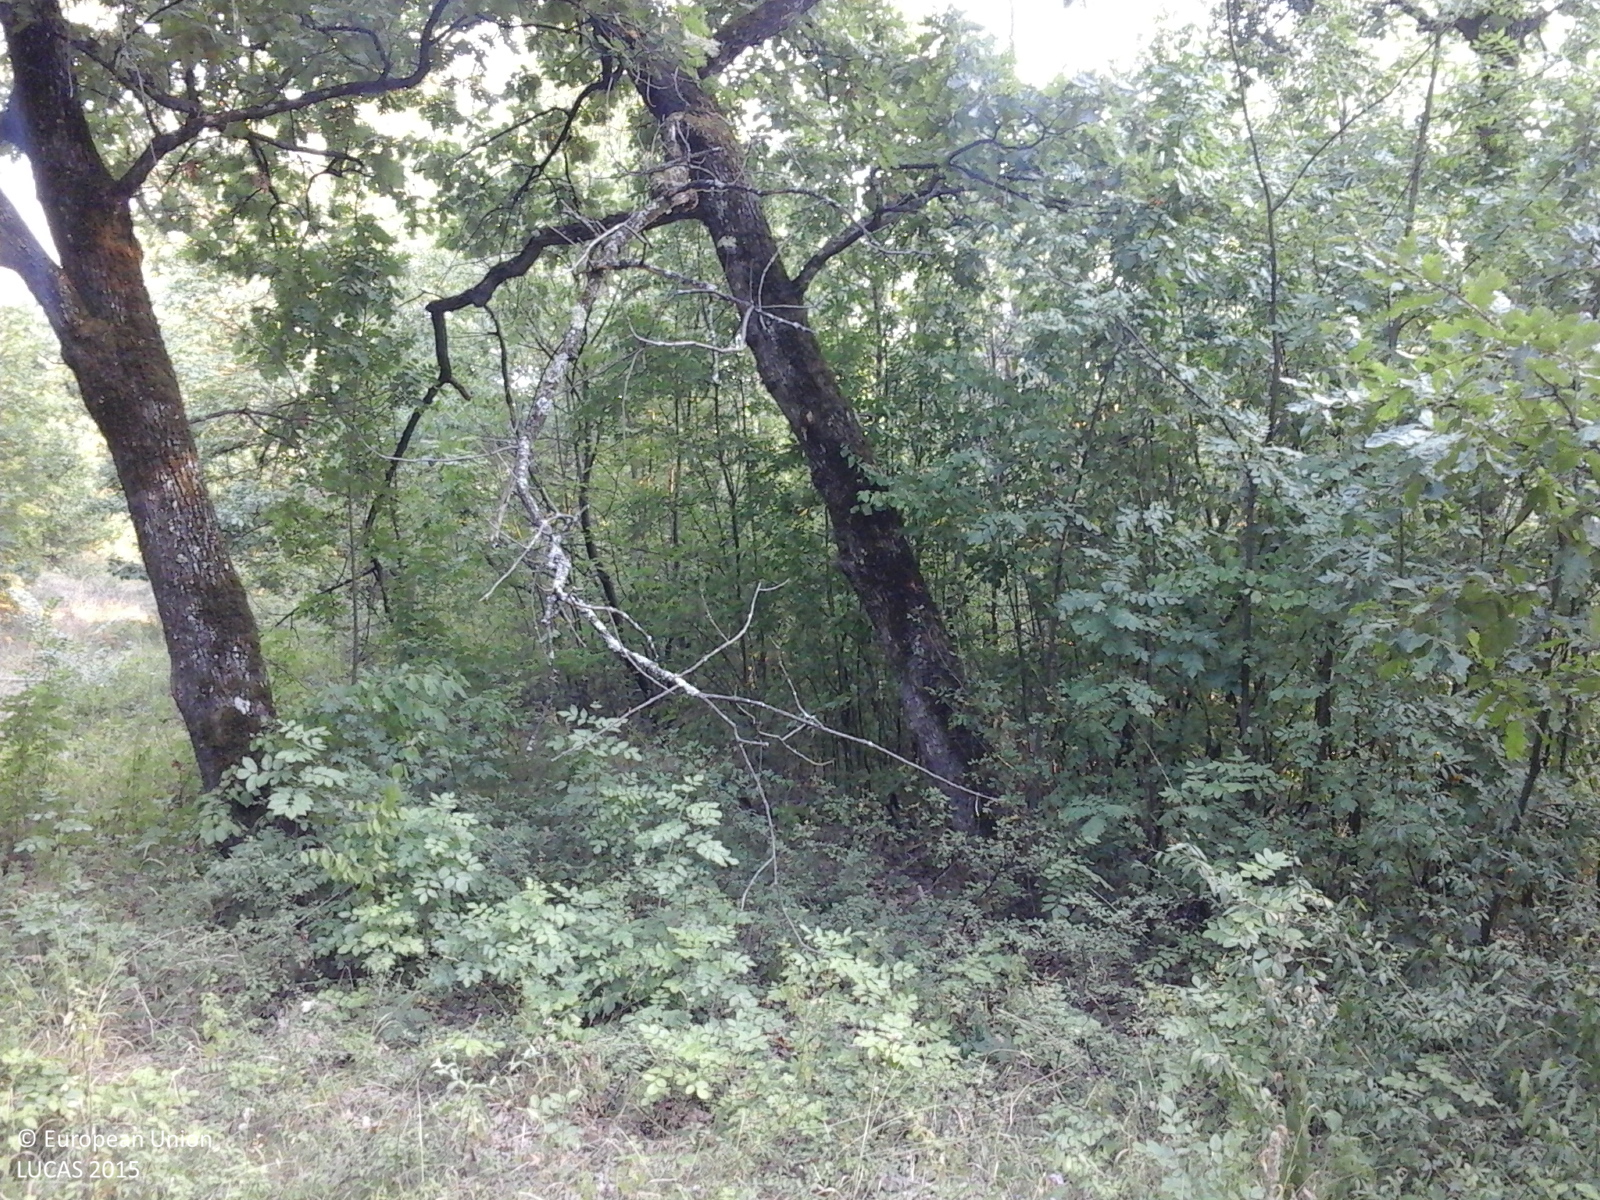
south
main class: Woodland
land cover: Broadleaved woodland
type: acidophilous oak and oak-birch forest
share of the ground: > 75 %
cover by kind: broadleaved forest trees 100 %
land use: Forestry
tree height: > 5 m
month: August
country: RO
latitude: 44.5788
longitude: 23.2100
